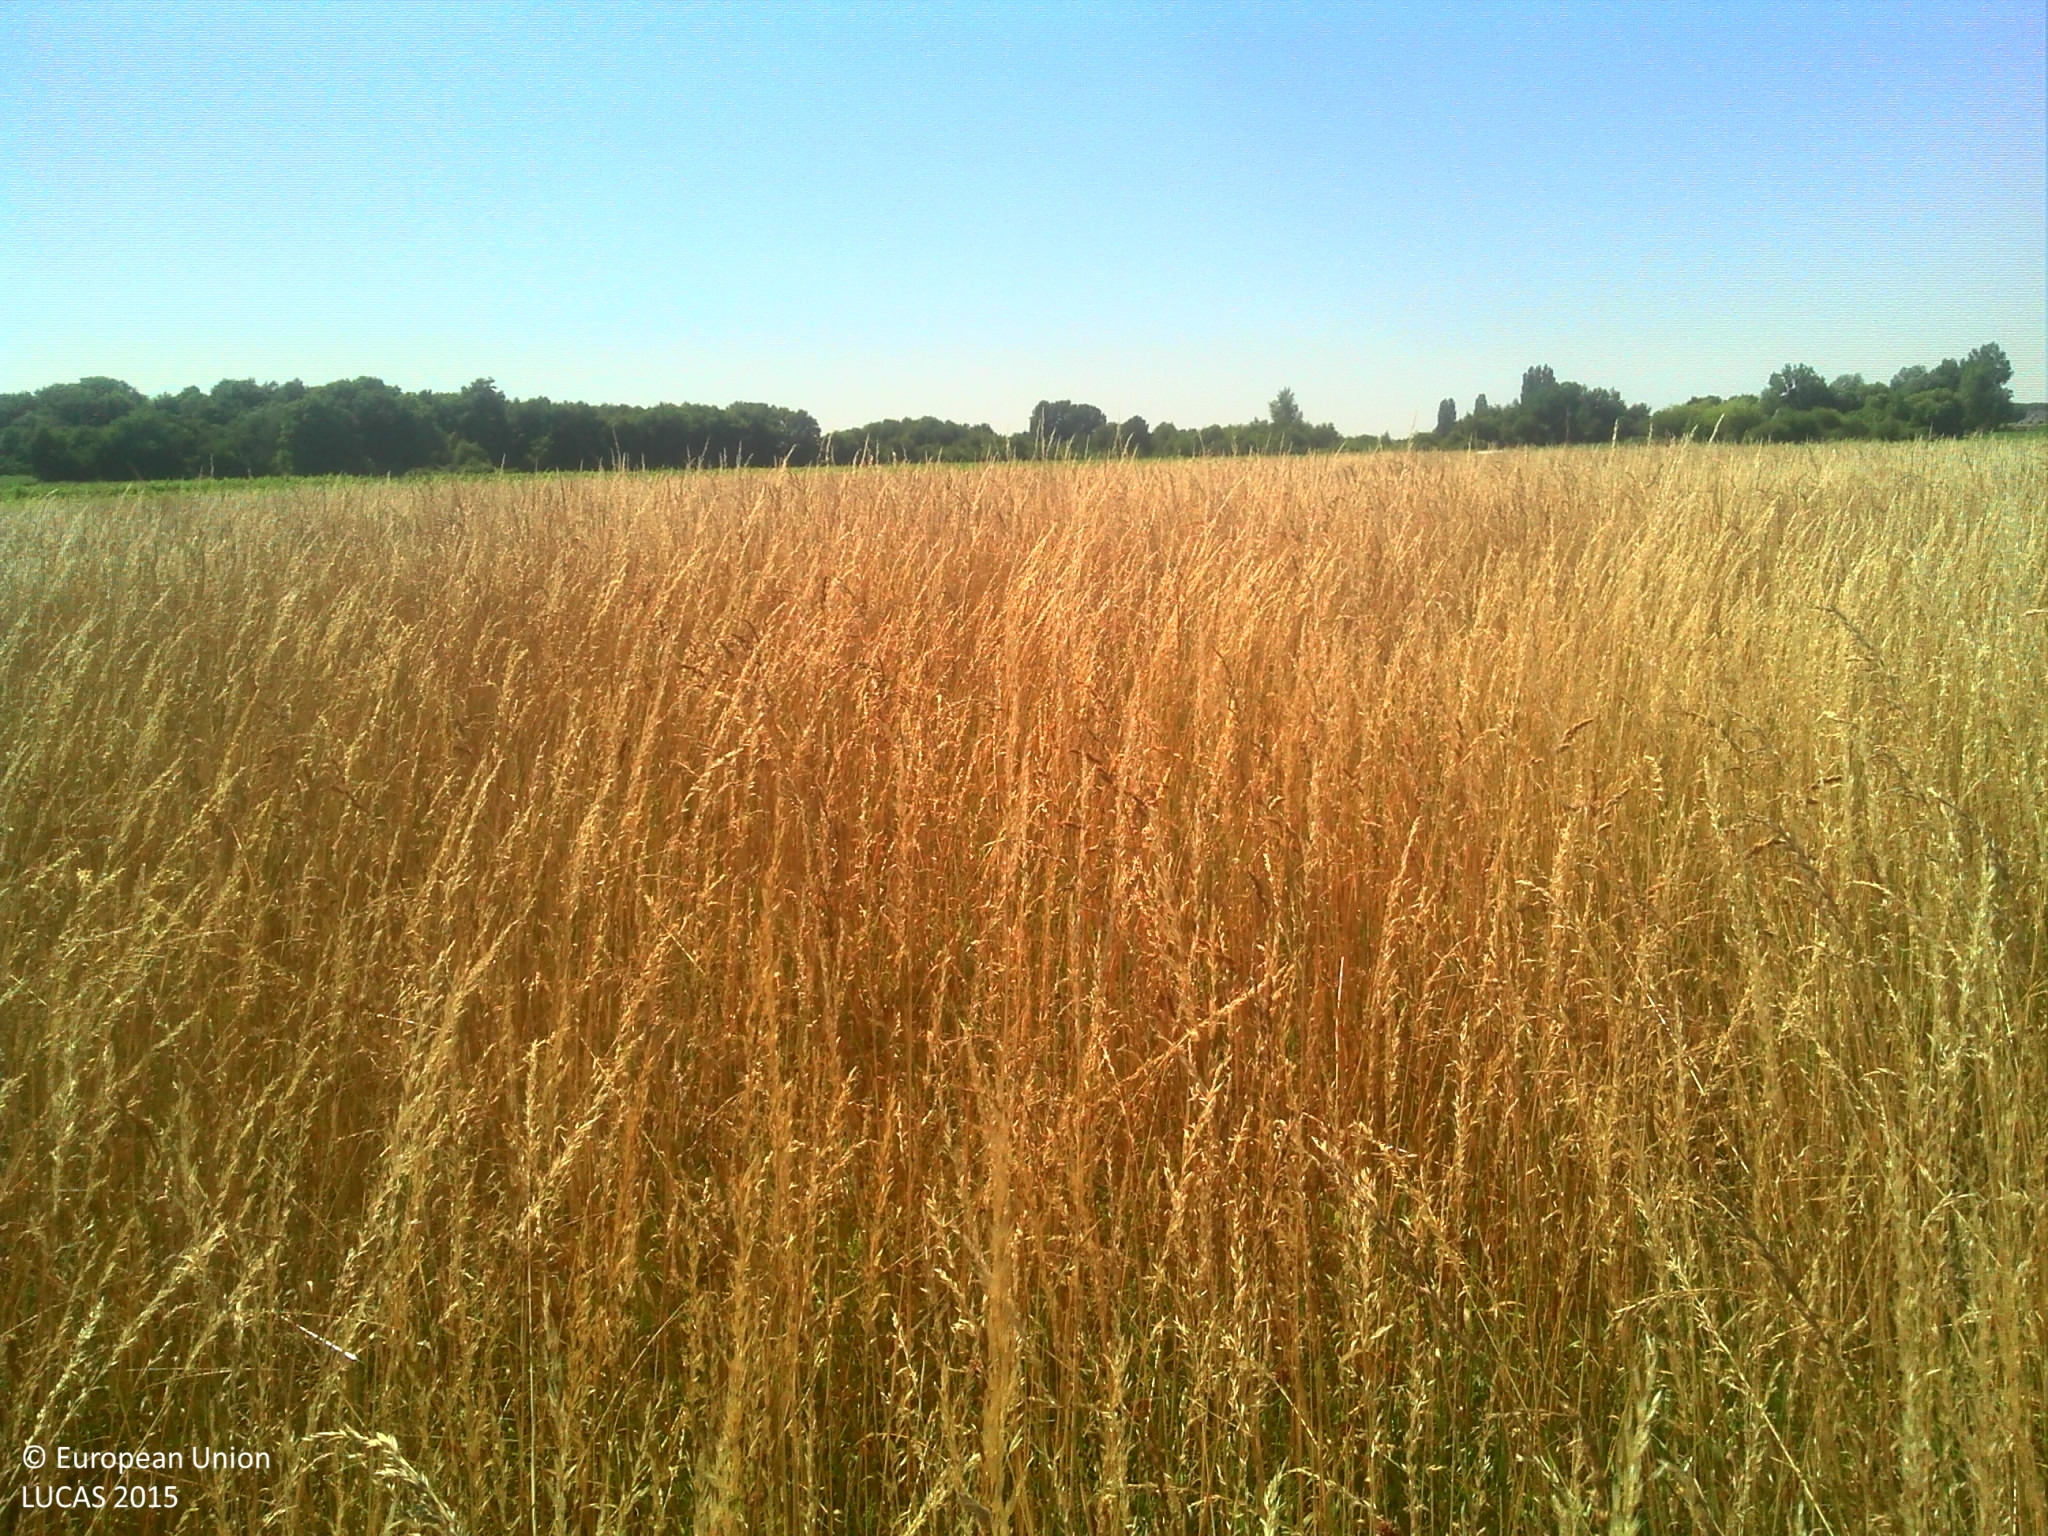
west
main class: Grassland
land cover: Grassland without tree/shrub cover
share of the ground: > 75 %
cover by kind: herbaceous plants 100 %
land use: Agriculture (excluding fallow land and kitchen gardens)
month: June
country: FR
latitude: 47.3458
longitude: 1.4221
